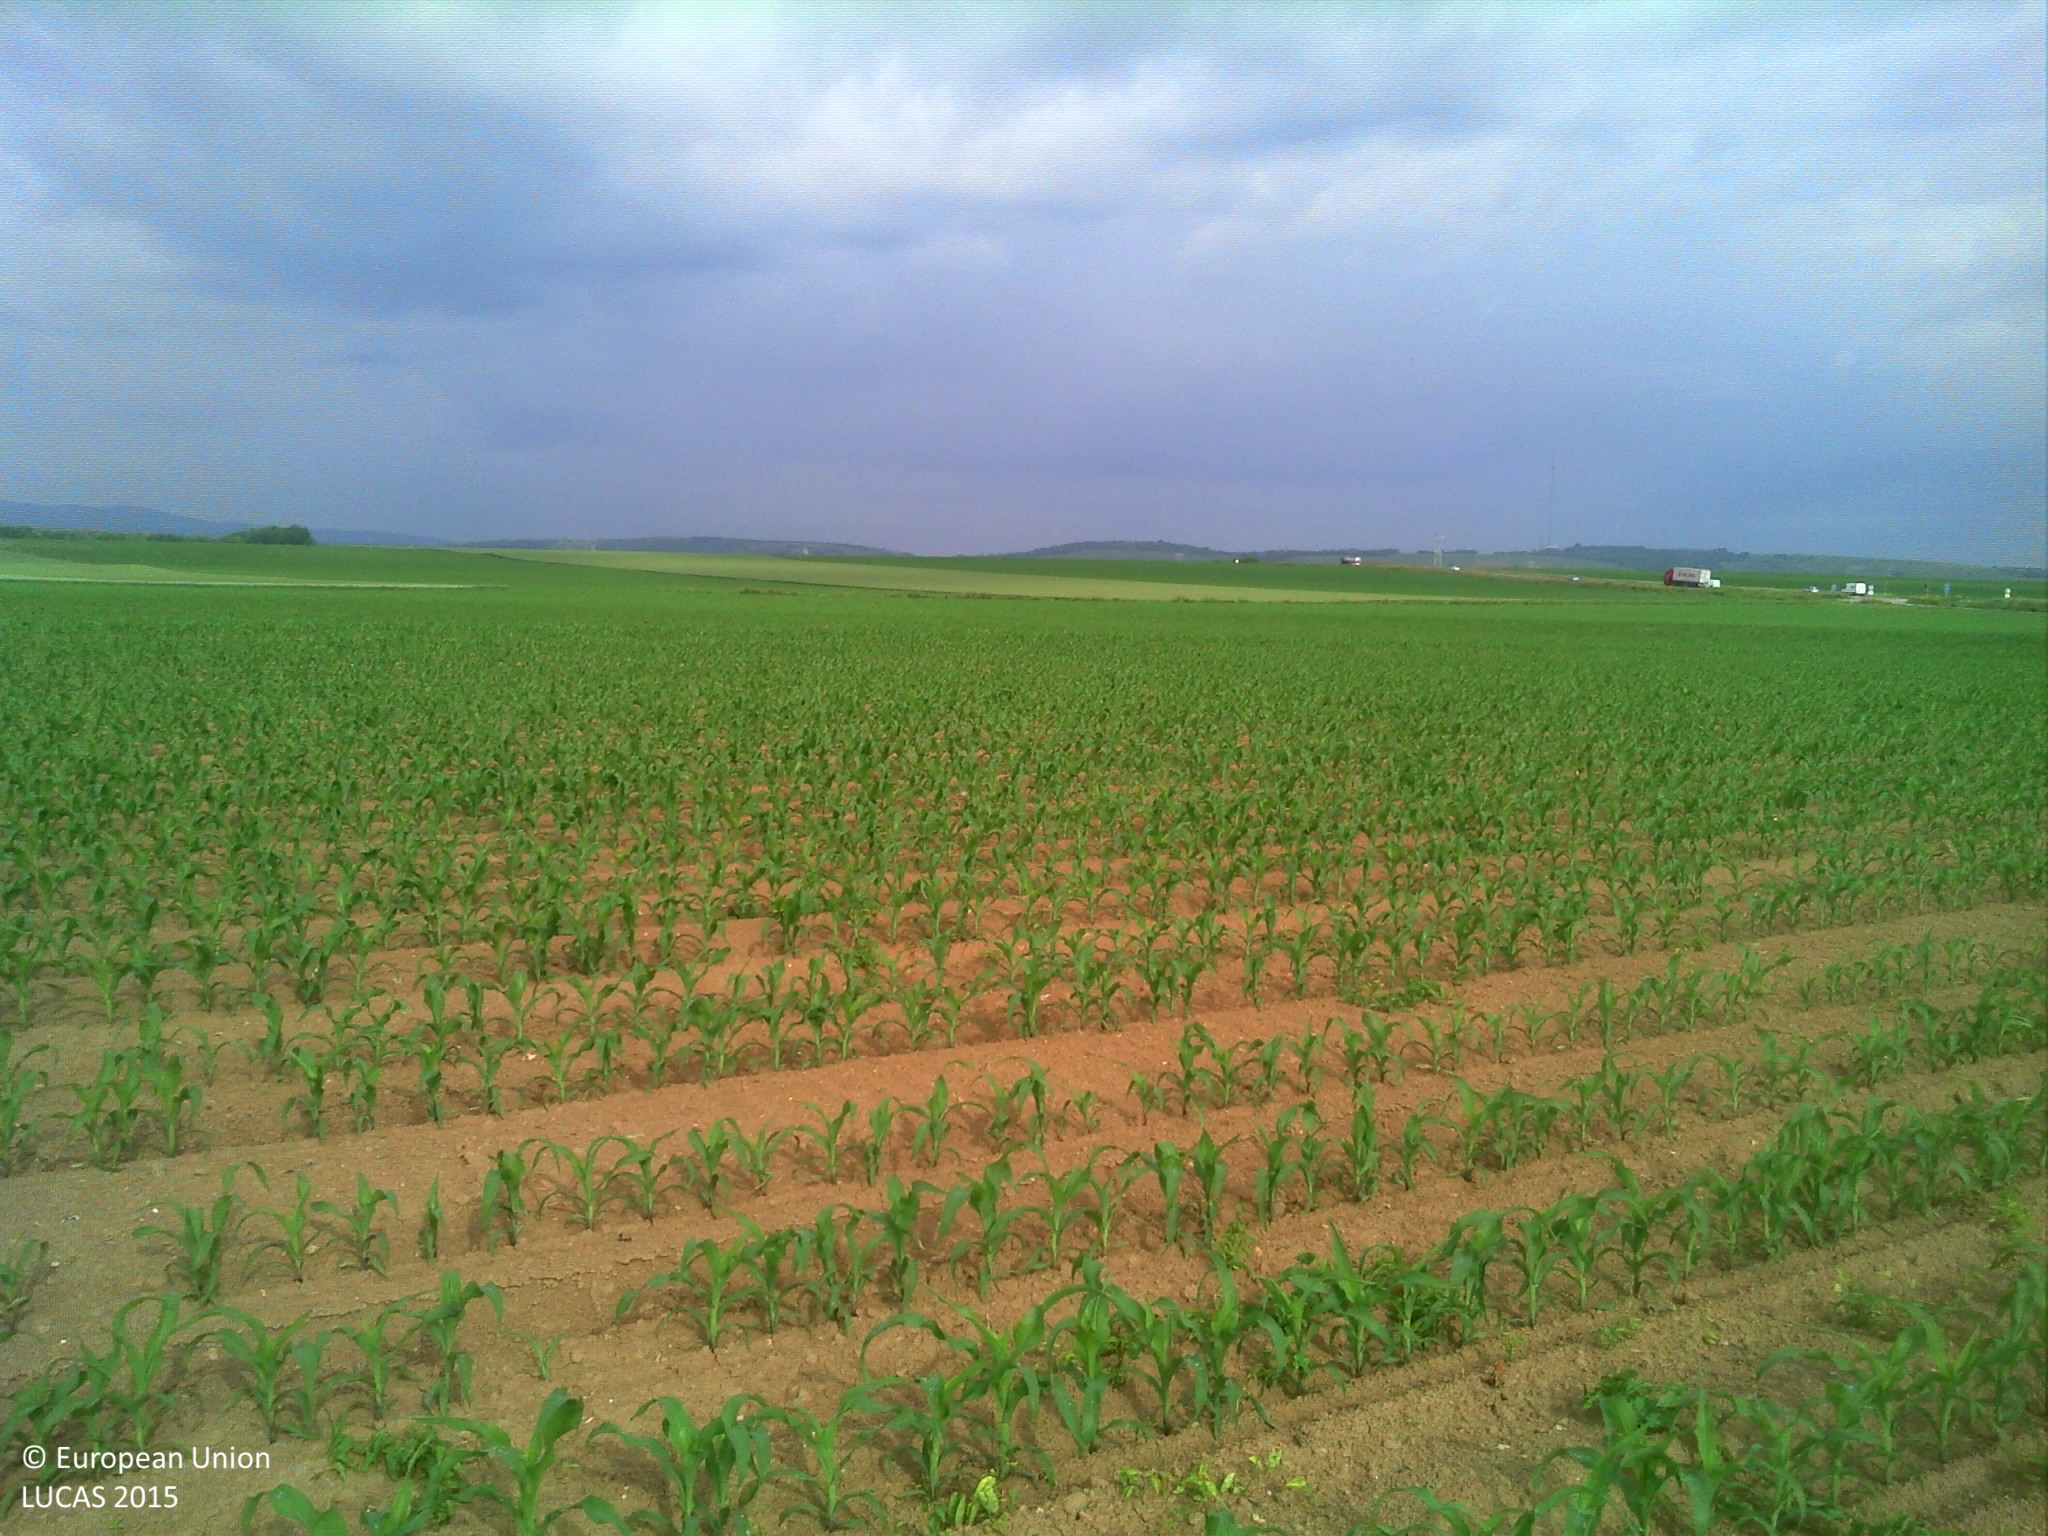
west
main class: Cropland
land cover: Maize
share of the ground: 10 - 25 %
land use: Agriculture (excluding fallow land and kitchen gardens)
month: May
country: FR
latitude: 48.6103
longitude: 7.5459
